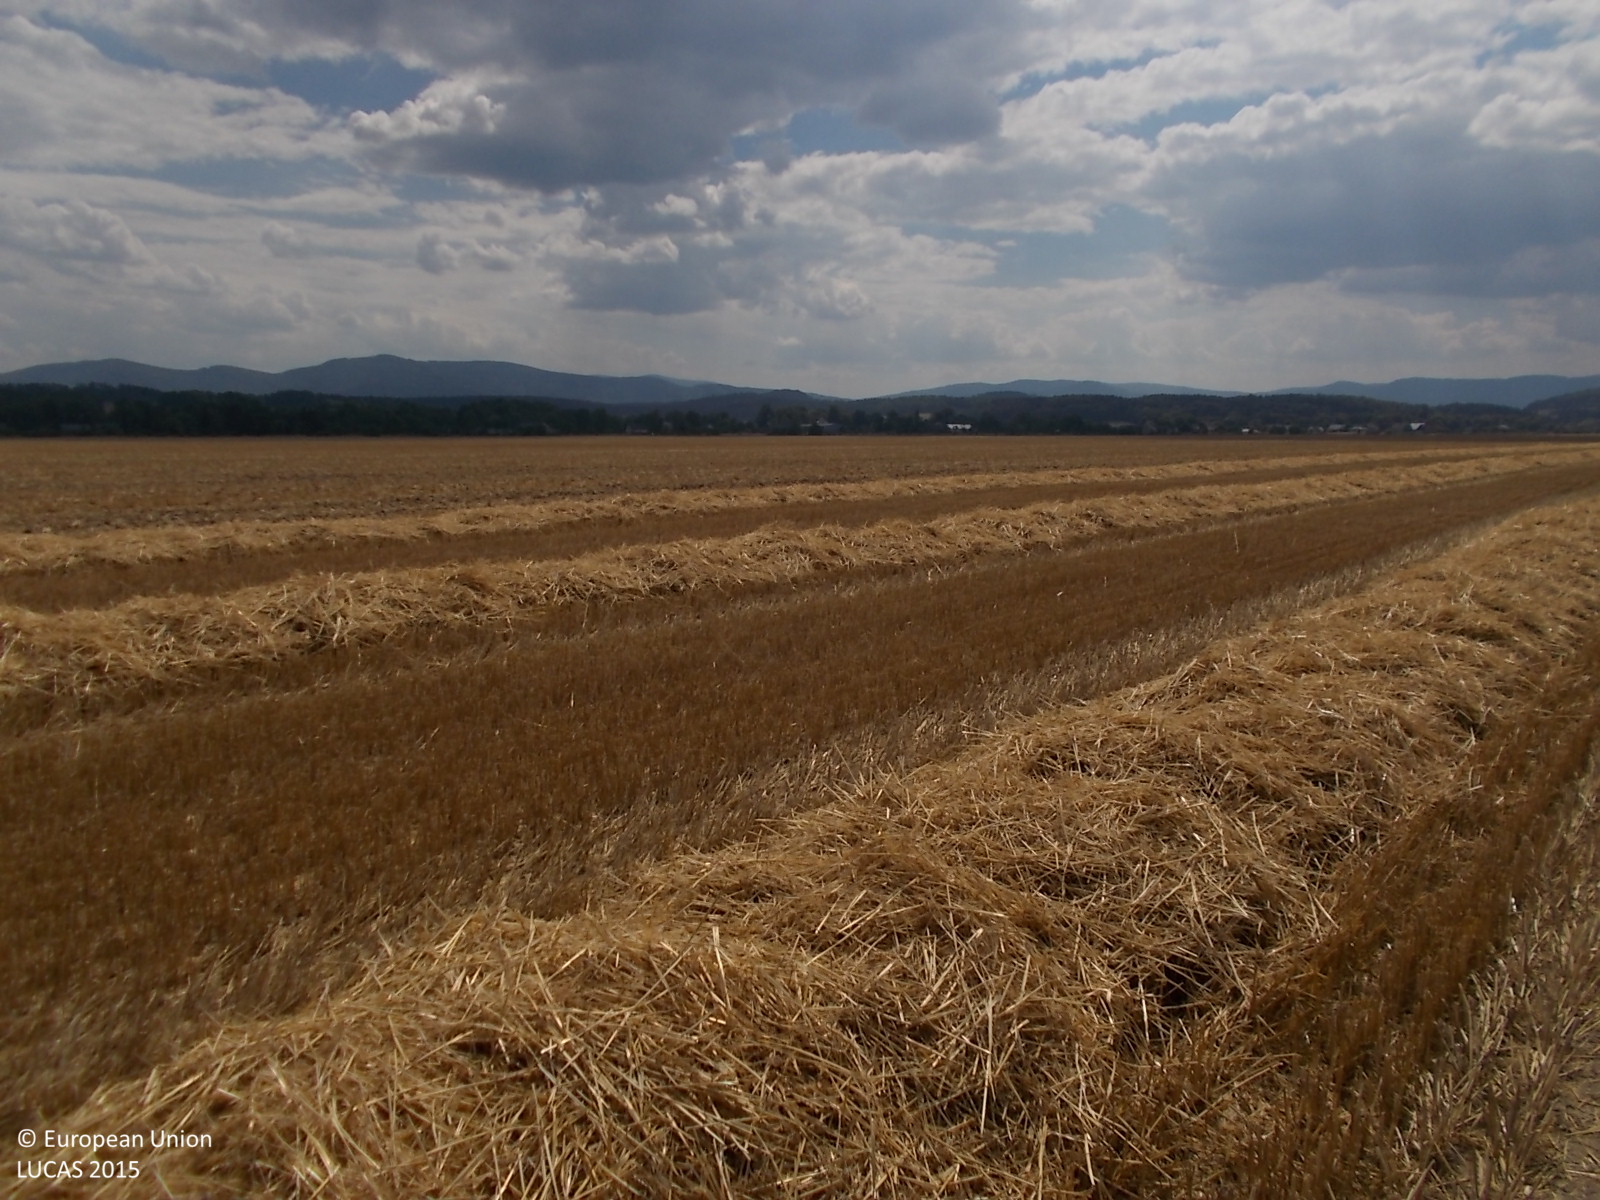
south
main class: Cropland
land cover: Common wheat
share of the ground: > 75 %
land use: Agriculture (excluding fallow land and kitchen gardens)
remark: Harvested field
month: August
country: CZ
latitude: 50.3738
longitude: 17.1677
